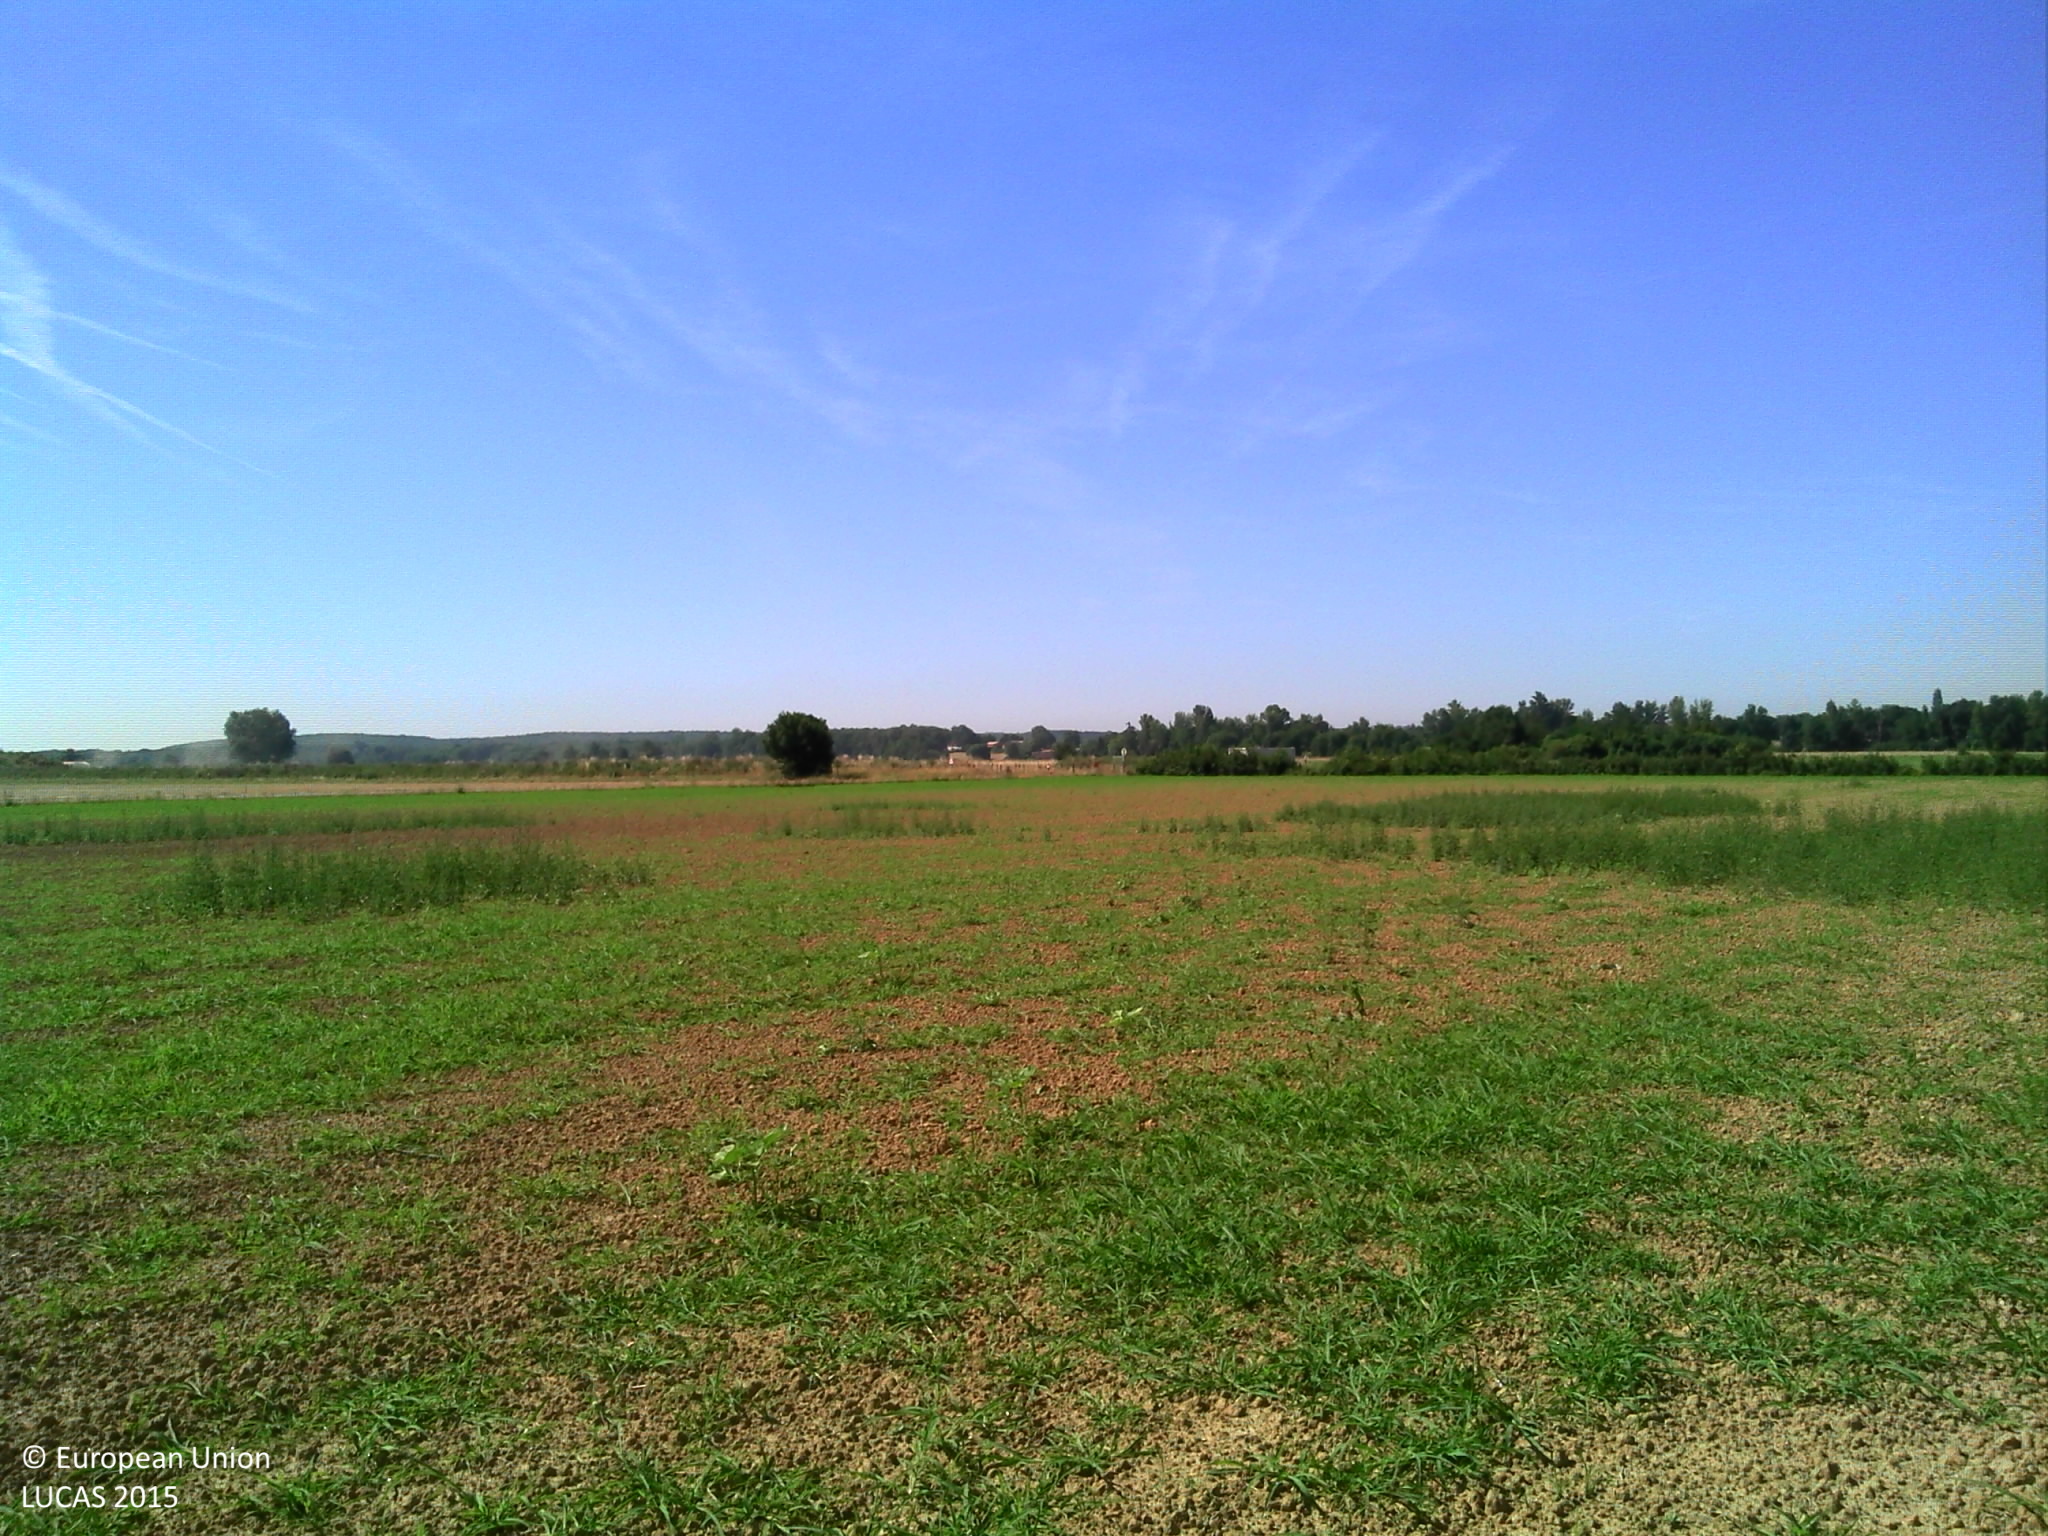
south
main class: Cropland
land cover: Temporary grasslands
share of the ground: 50 - 75 %
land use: Agriculture (excluding fallow land and kitchen gardens)
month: June
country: FR
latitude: 43.8070
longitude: 1.5616
